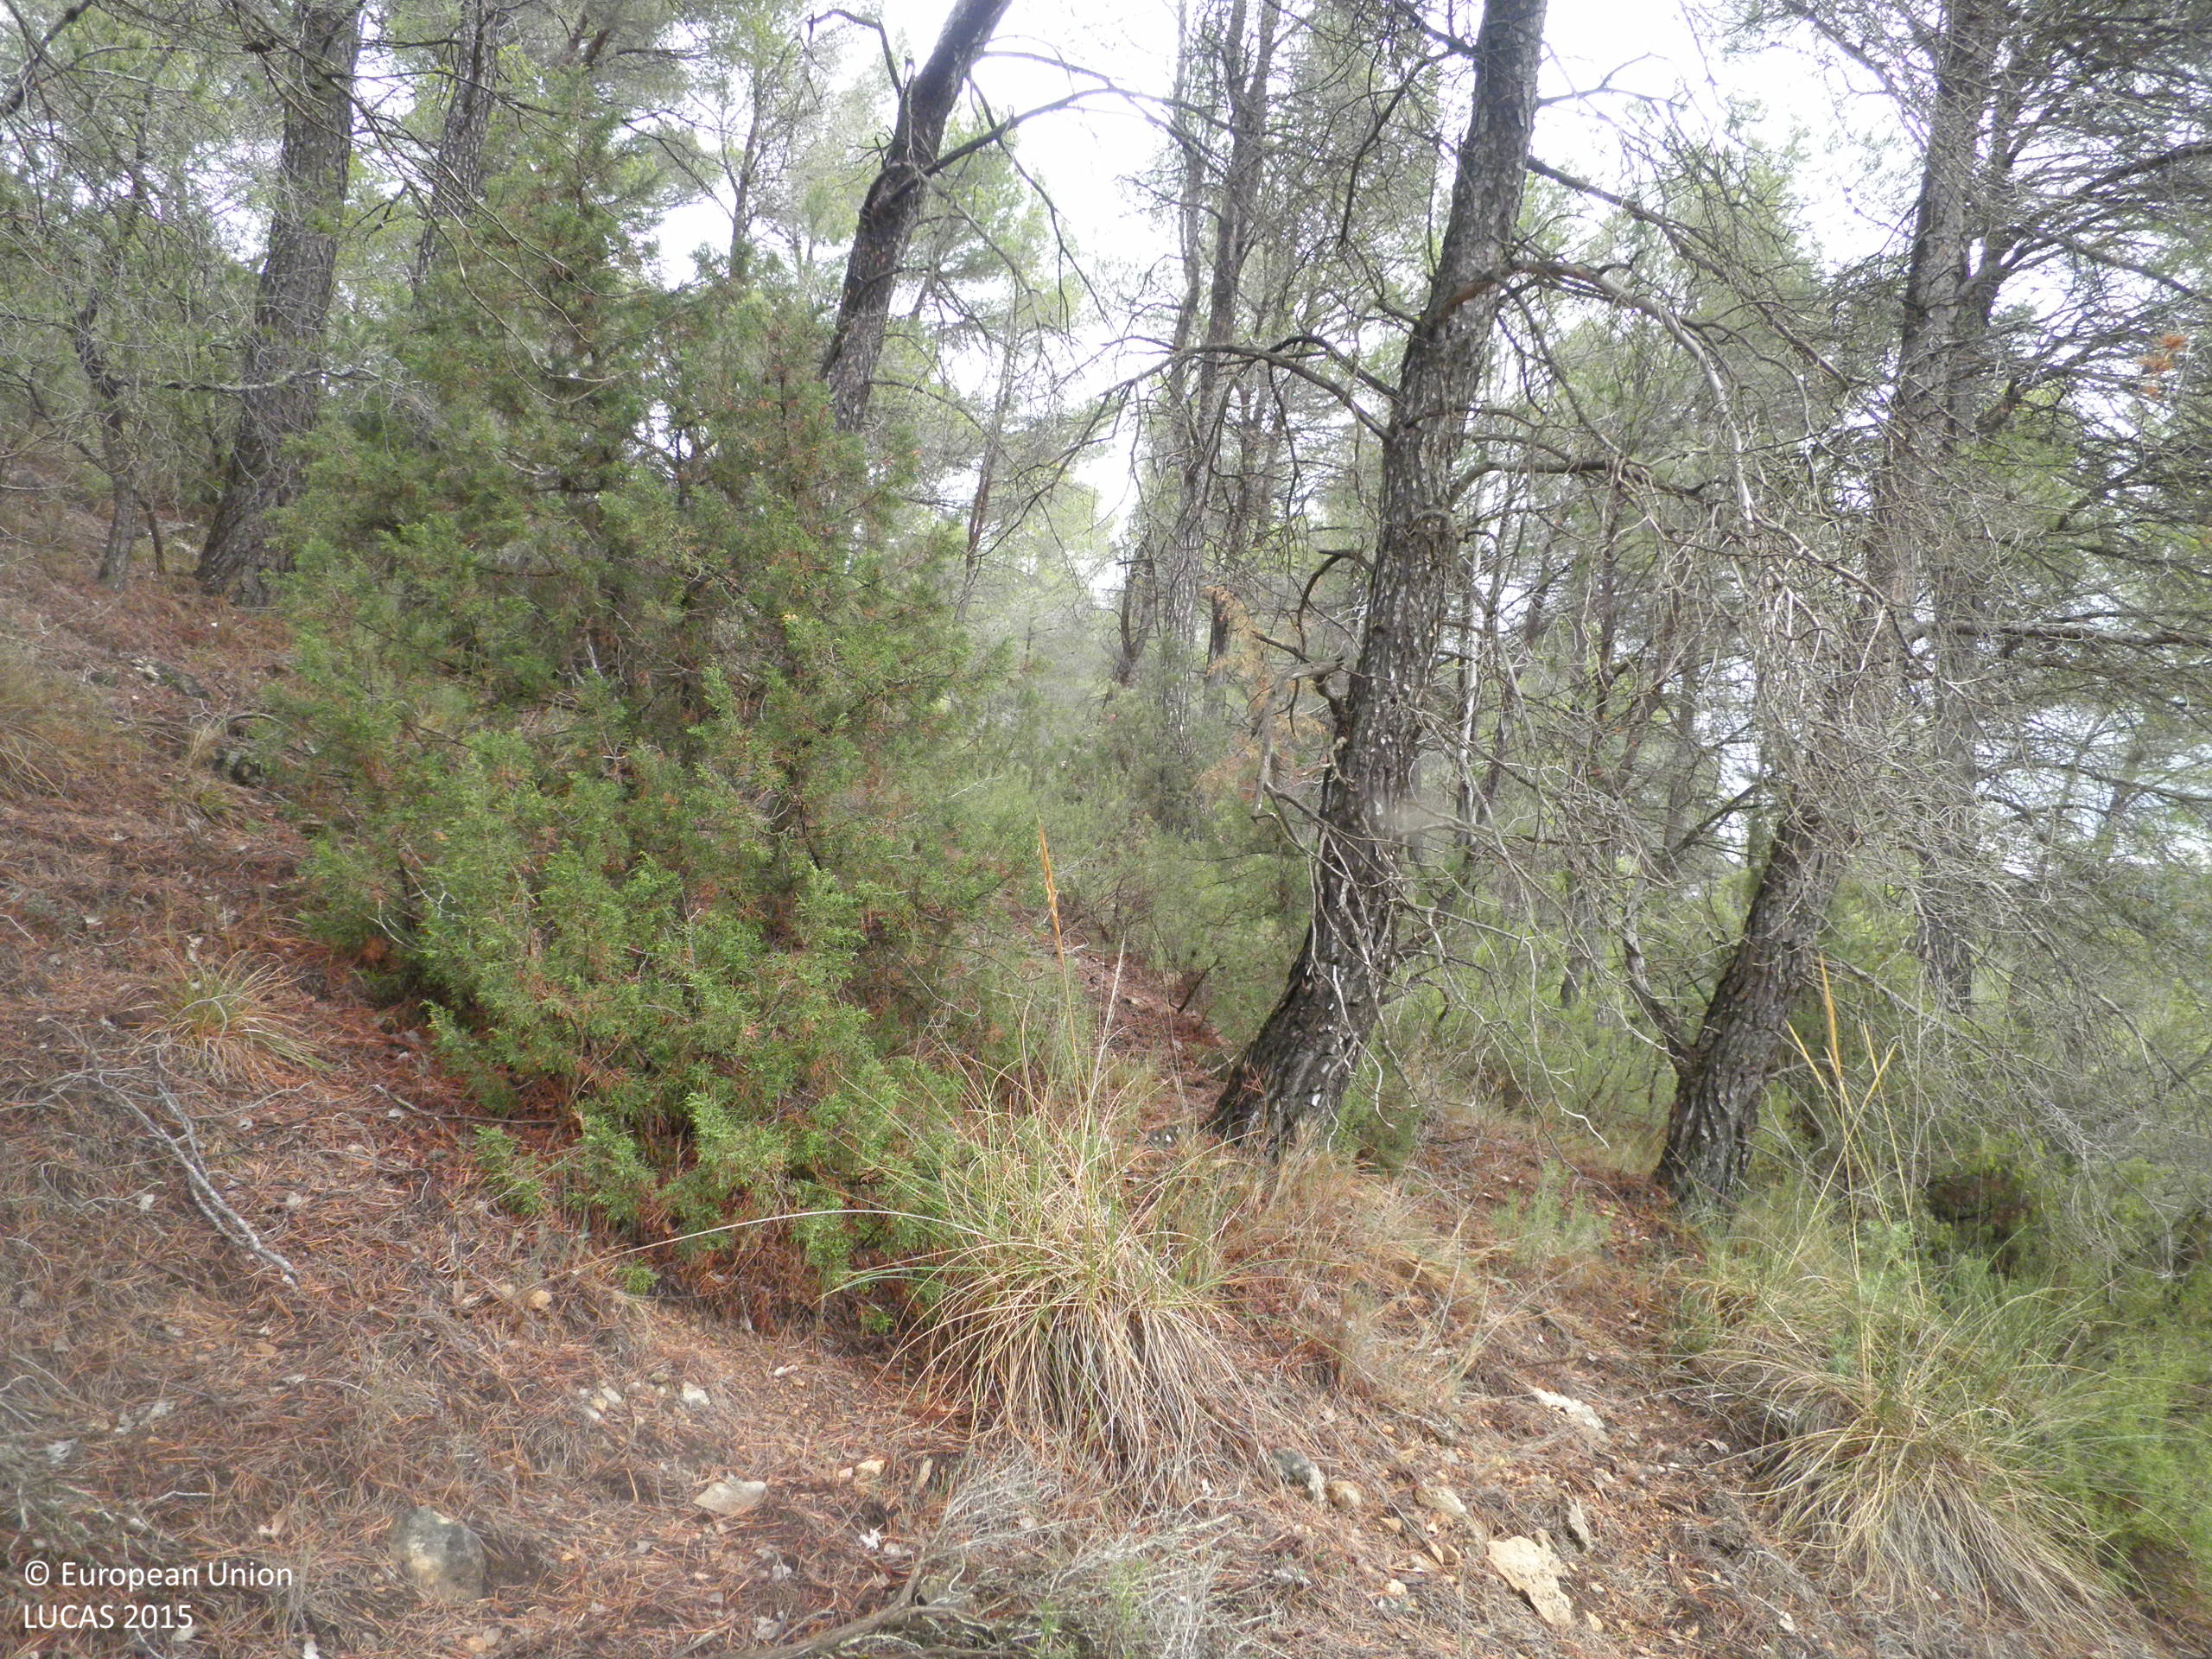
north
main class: Woodland
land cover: Pine dominated coniferous woodland
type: coniferous forest of the mediterranean region
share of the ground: 25 - 50 %
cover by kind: coniferous forest trees 35 %, unconsolidated bare surface 30 %, shrubs 20 %, herbaceous plants 15 %
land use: Semi-natural and natural areas not in use
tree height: > 5 m
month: June
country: ES
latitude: 39.6908
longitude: -1.5626
